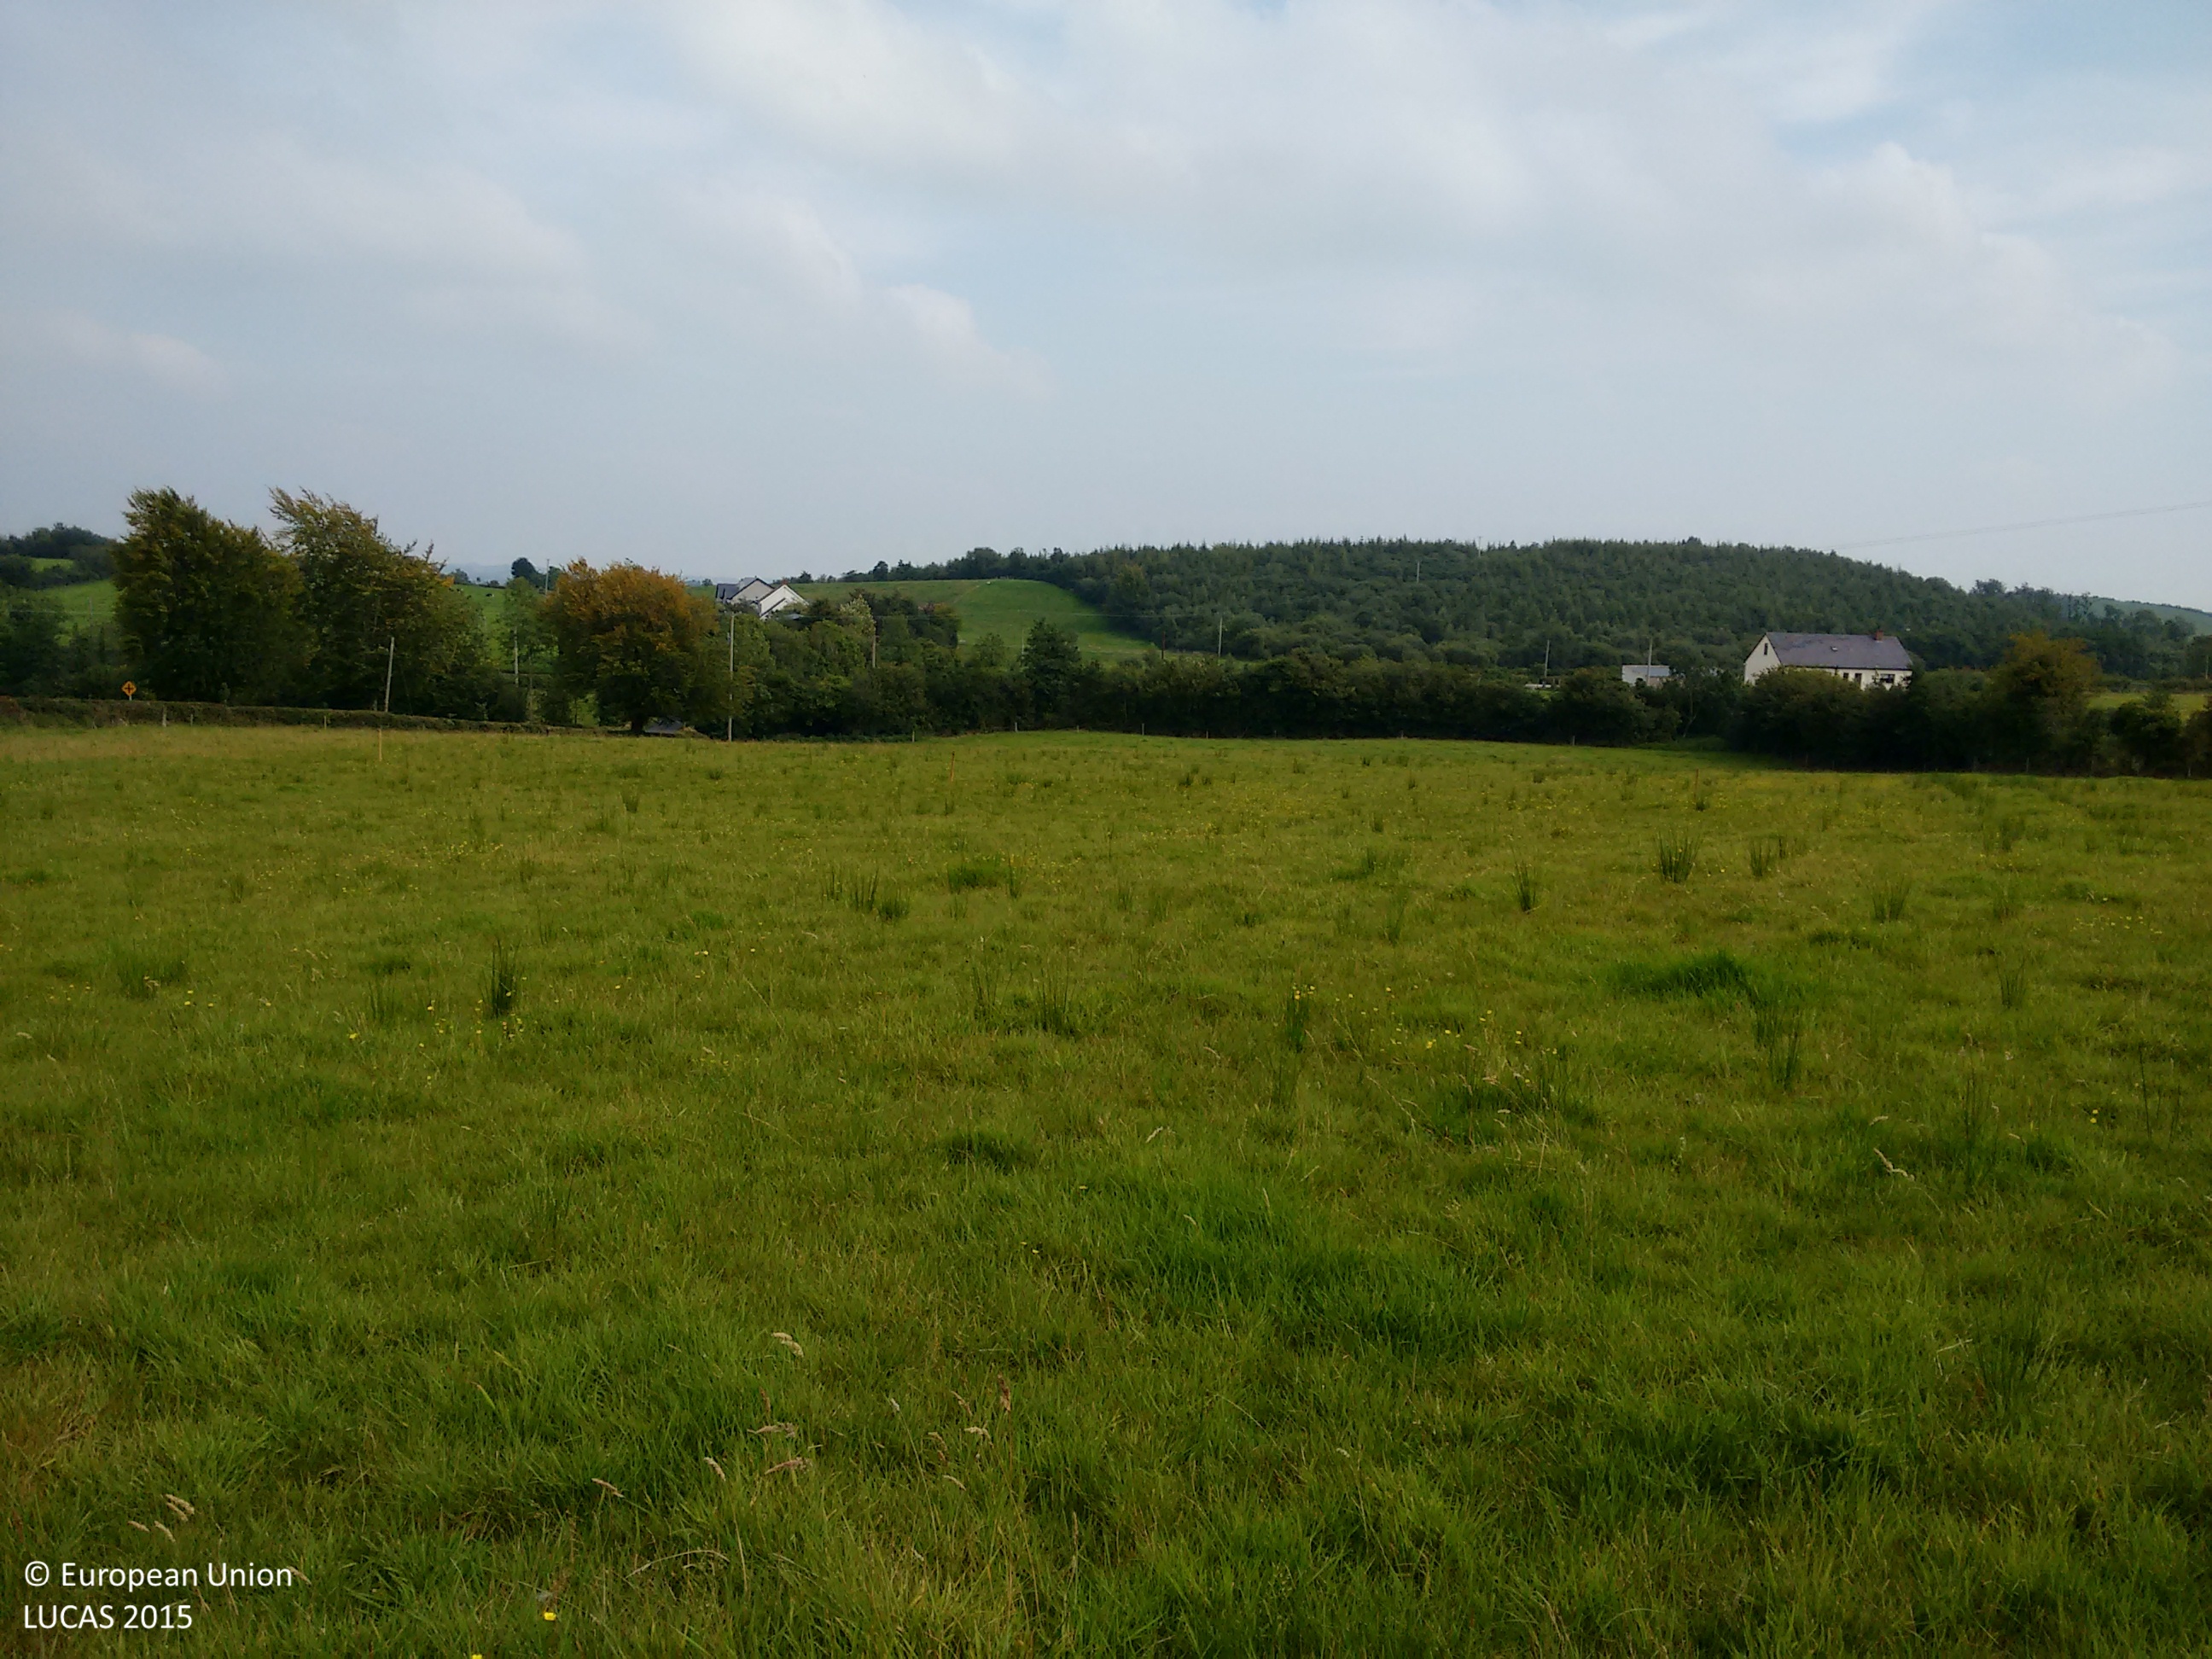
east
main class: Grassland
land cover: Grassland without tree/shrub cover
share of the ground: > 75 %
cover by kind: herbaceous plants 100 %
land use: Agriculture (excluding fallow land and kitchen gardens)
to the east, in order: Grassland without tree/shrub cover; Fences; Grassland without tree/shrub cover; Electric lines; Grassland without tree/shrub cover; Fences; Managed hedges; Grassland without tree/shrub cover; Electric lines; Fences; Grassland without tree/shrub cover; Fences; Managed hedges; Electric lines; Grass margins; Tracks; Grass margins; Managed hedges; Fences; Grassland without tree/shrub cover
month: September
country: IE
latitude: 54.3734
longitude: -7.0278
